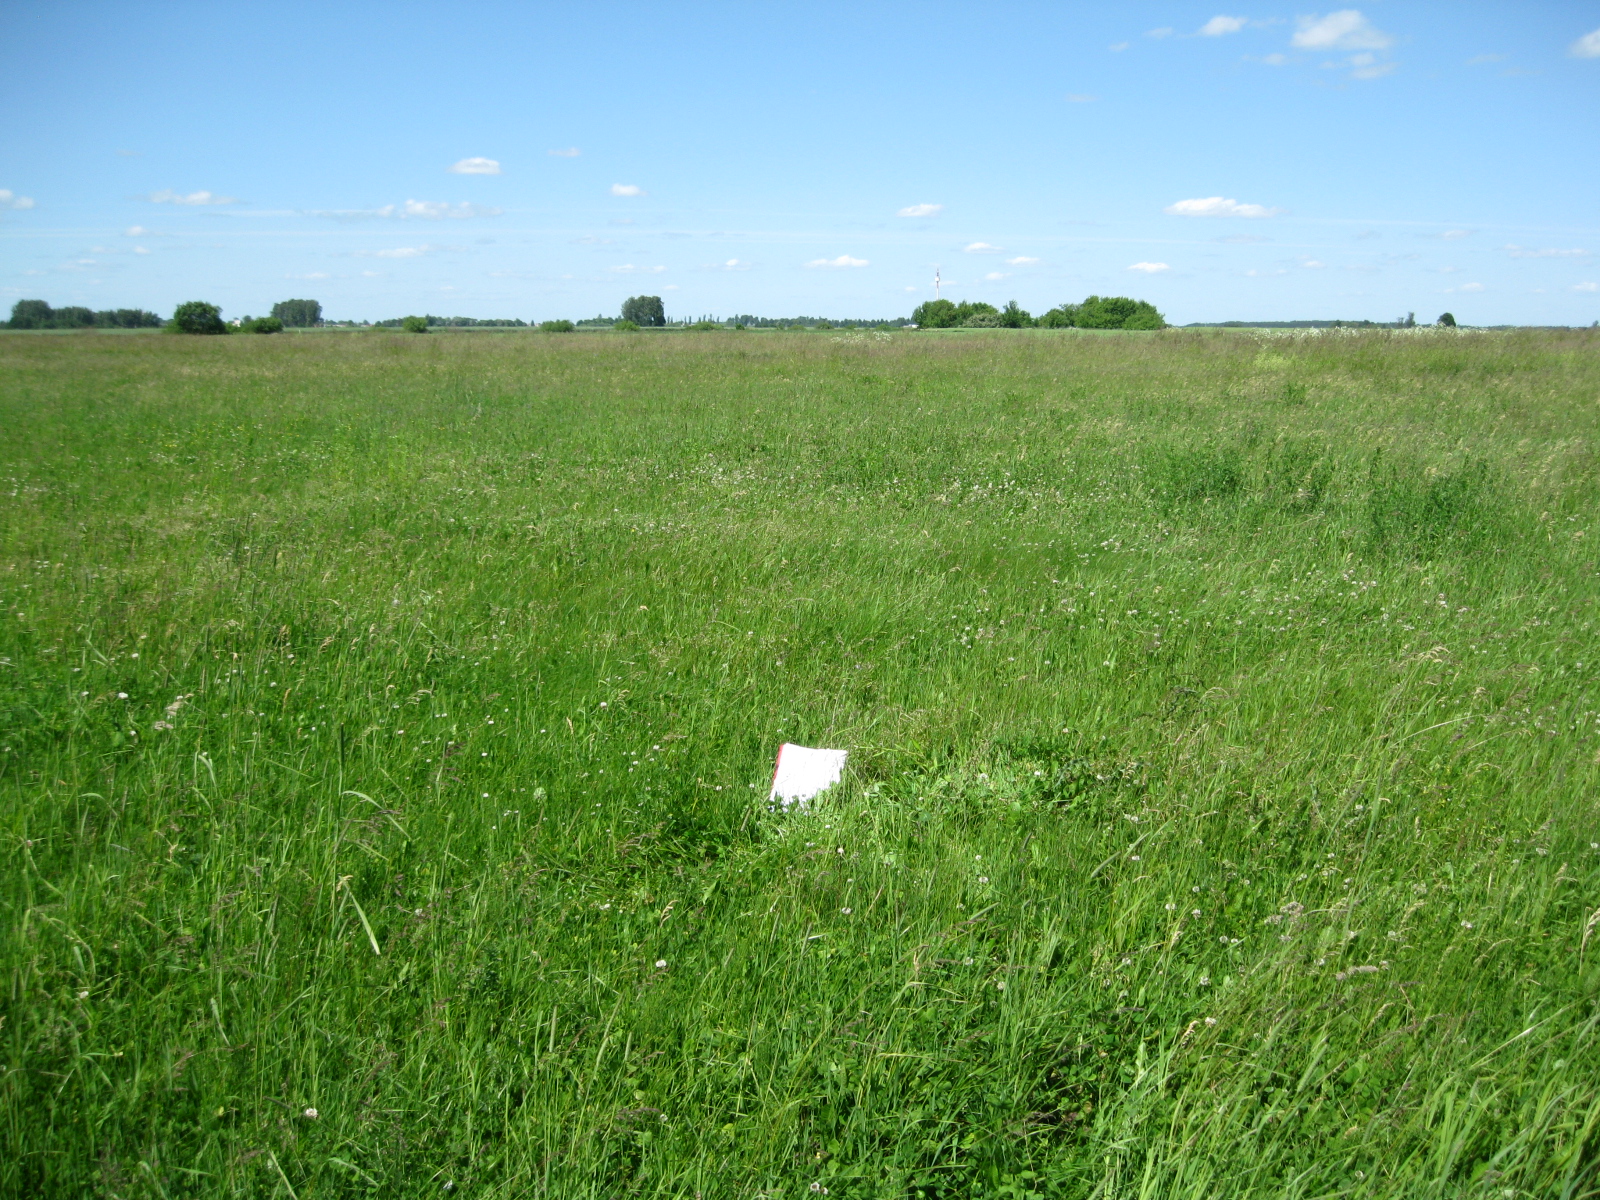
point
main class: Grassland
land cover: Grassland without tree/shrub cover
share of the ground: > 75 %
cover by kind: herbaceous plants 100 %
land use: Agriculture (excluding fallow land and kitchen gardens)
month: June
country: LT
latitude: 55.2278
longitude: 23.8759
